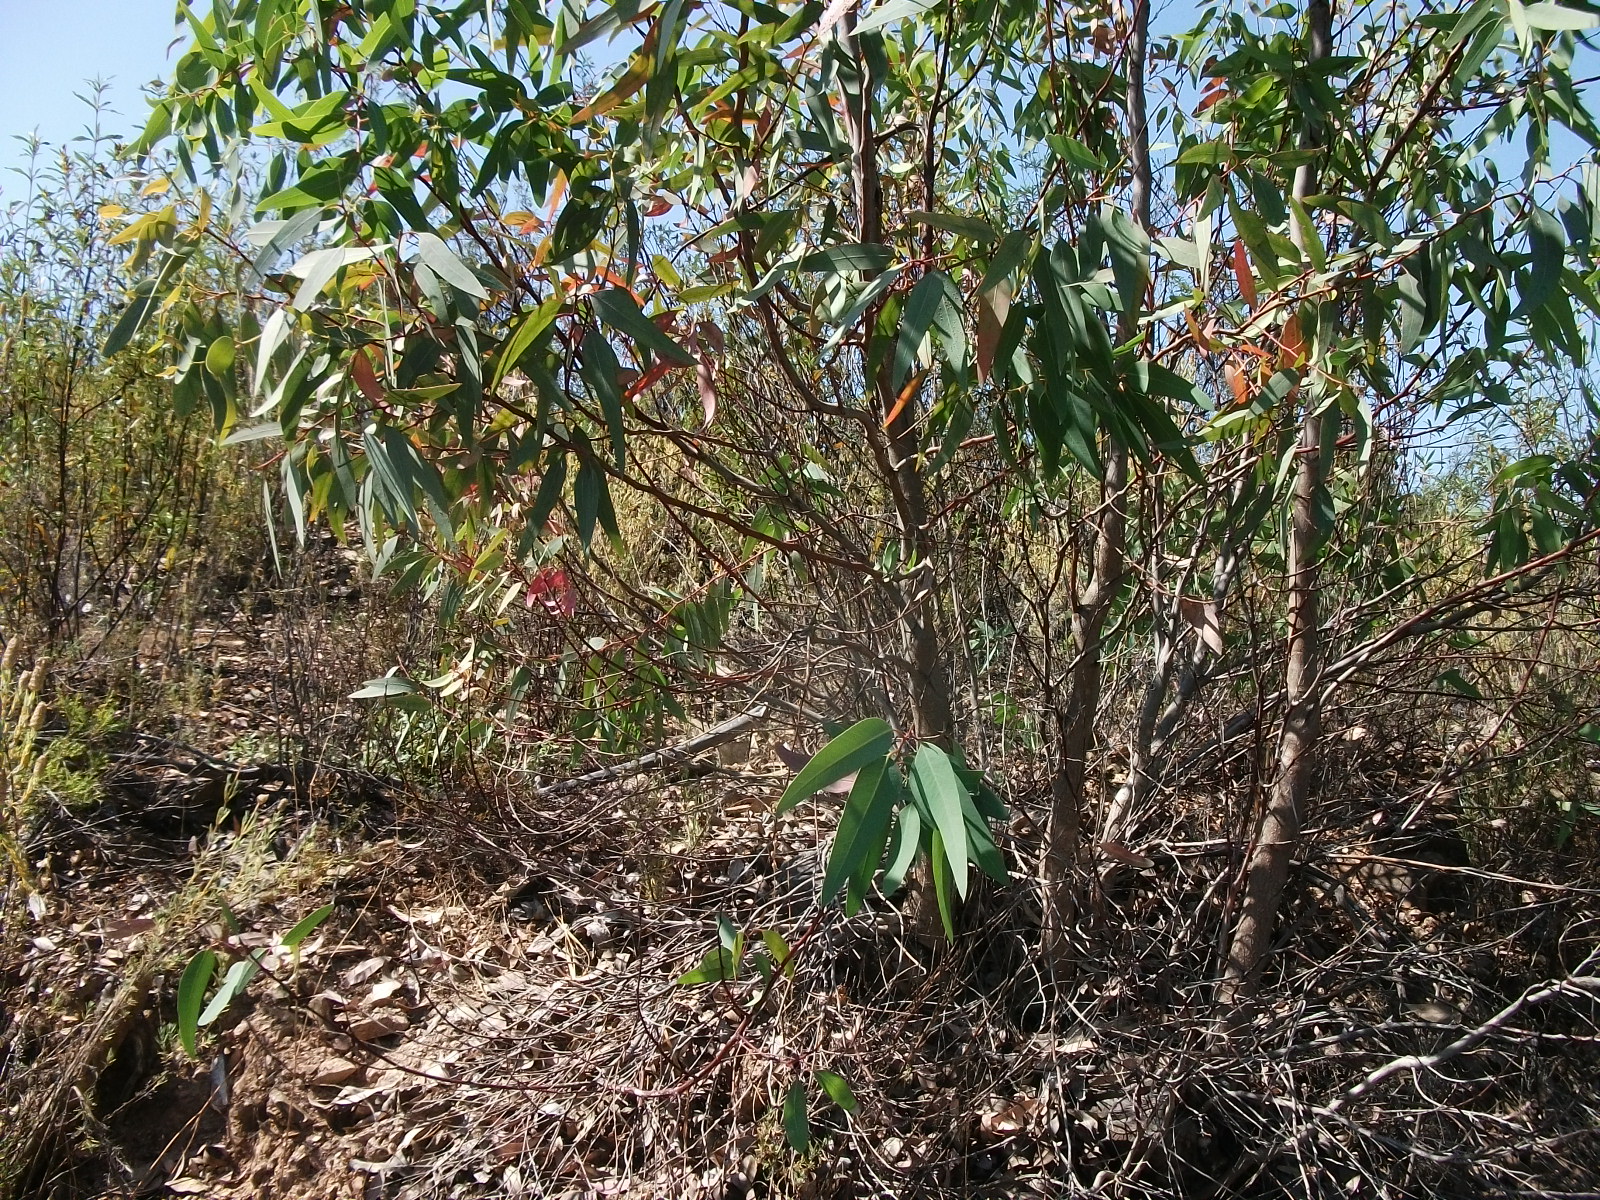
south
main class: Woodland
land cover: Broadleaved woodland
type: exotic forest
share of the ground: 10 - 25 %
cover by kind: shrubs 80 %, broadleaved forest trees 20 %
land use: Forestry
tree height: < 5 m
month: June
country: ES
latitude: 37.4868
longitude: -6.6509
